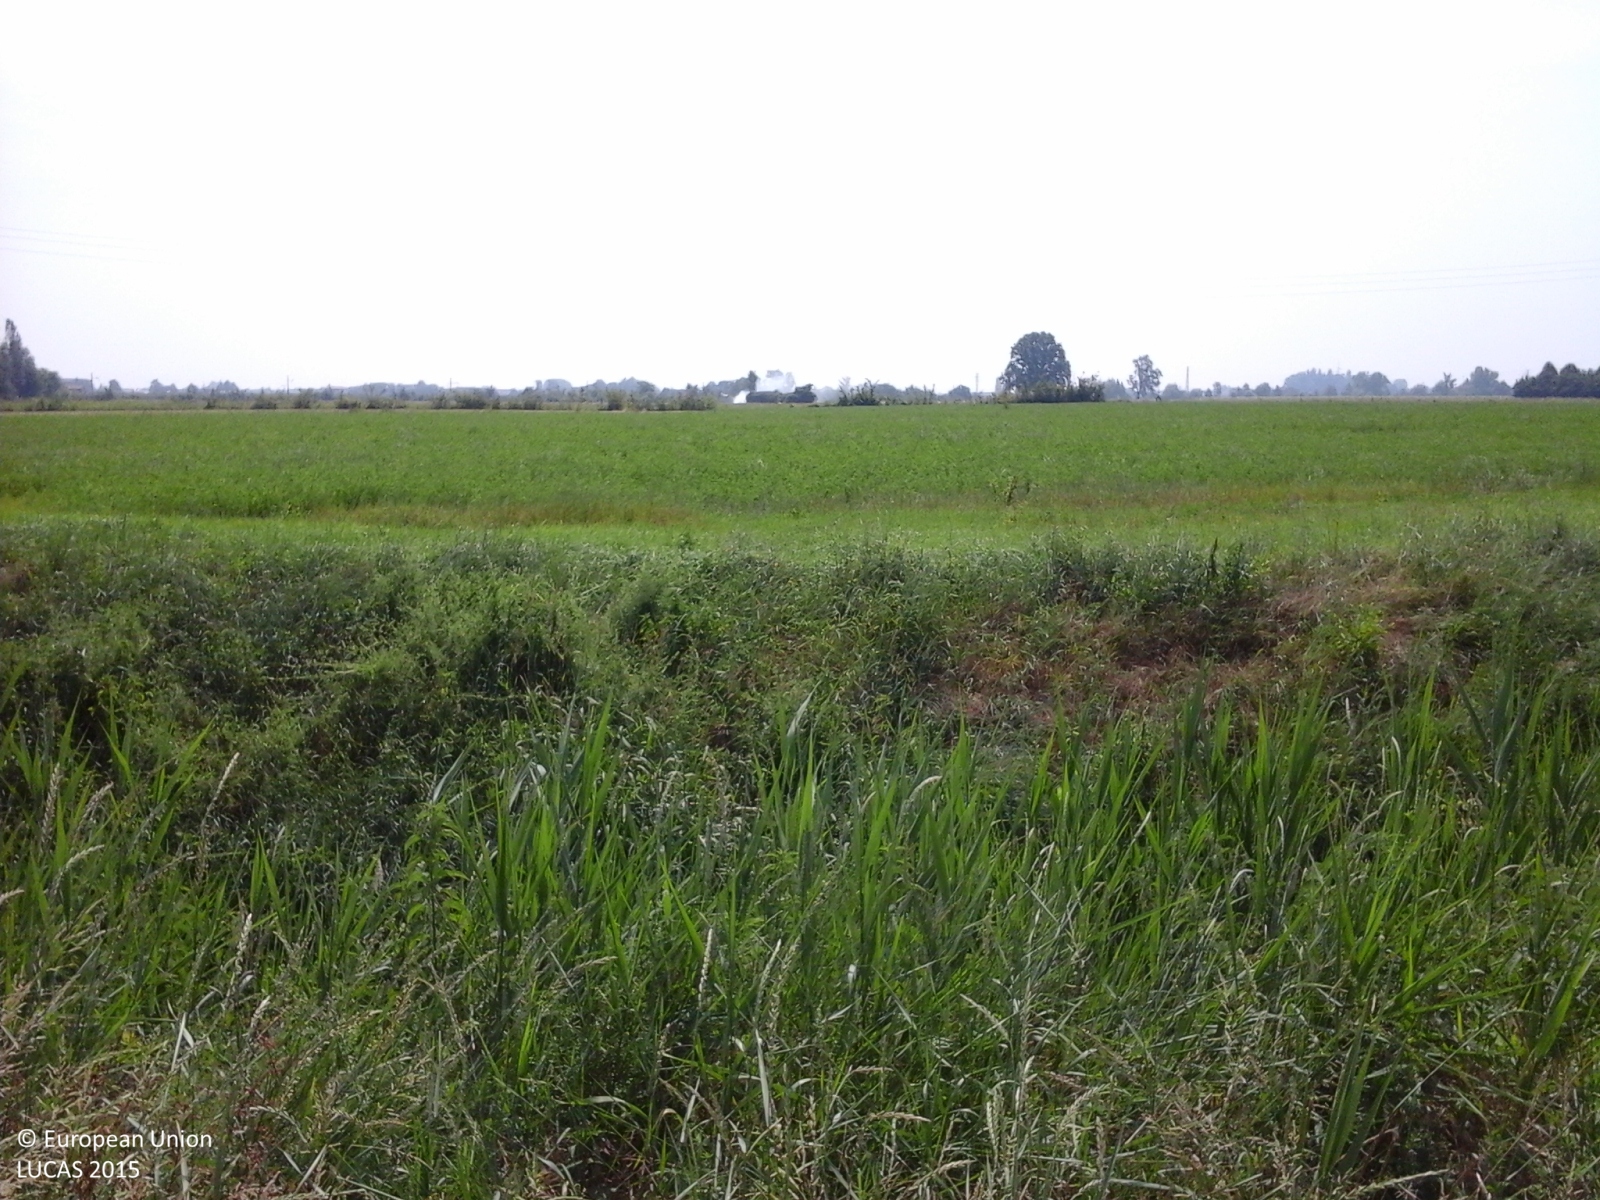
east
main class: Cropland
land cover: Common wheat
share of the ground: > 75 %
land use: Agriculture (excluding fallow land and kitchen gardens)
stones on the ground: < 10 %
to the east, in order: Common wheat; Grassland without tree/shrub cover; Single bushes/trees; Rivers and streams; Grassland without tree/shrub cover; Tracks; Lucerne; Electric lines; Lucerne
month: May
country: IT
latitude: 44.7435
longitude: 10.8948
